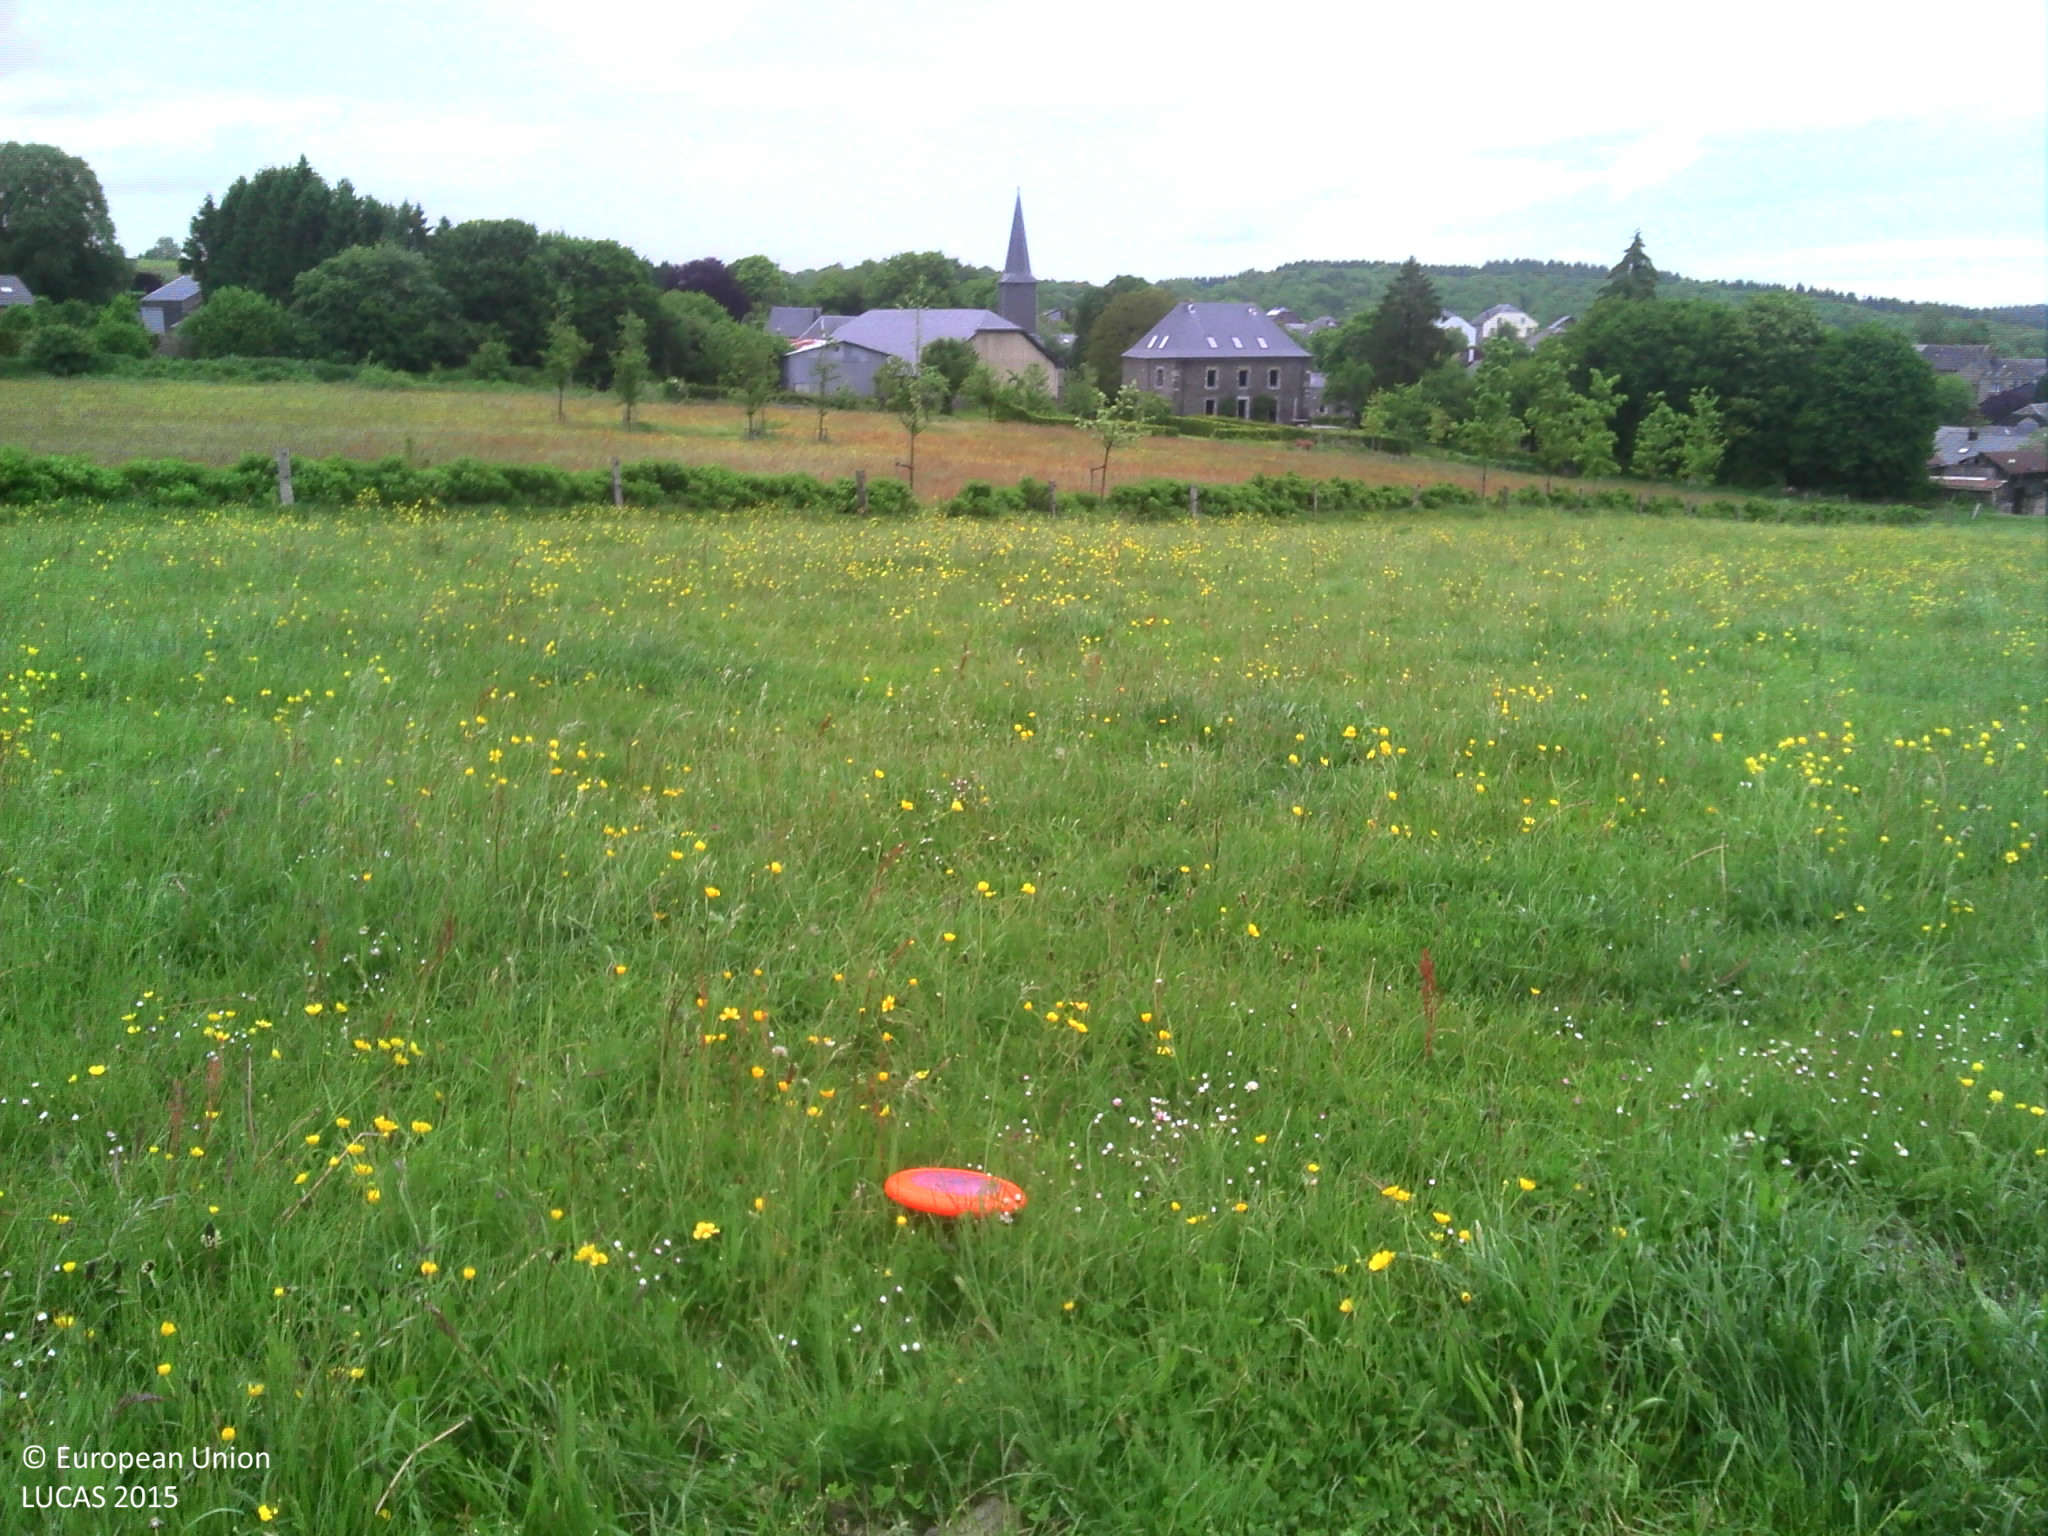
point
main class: Grassland
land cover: Grassland without tree/shrub cover
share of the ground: > 75 %
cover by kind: herbaceous plants 100 %
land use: Agriculture (excluding fallow land and kitchen gardens)
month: June
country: BE
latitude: 49.9087
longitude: 4.9146
